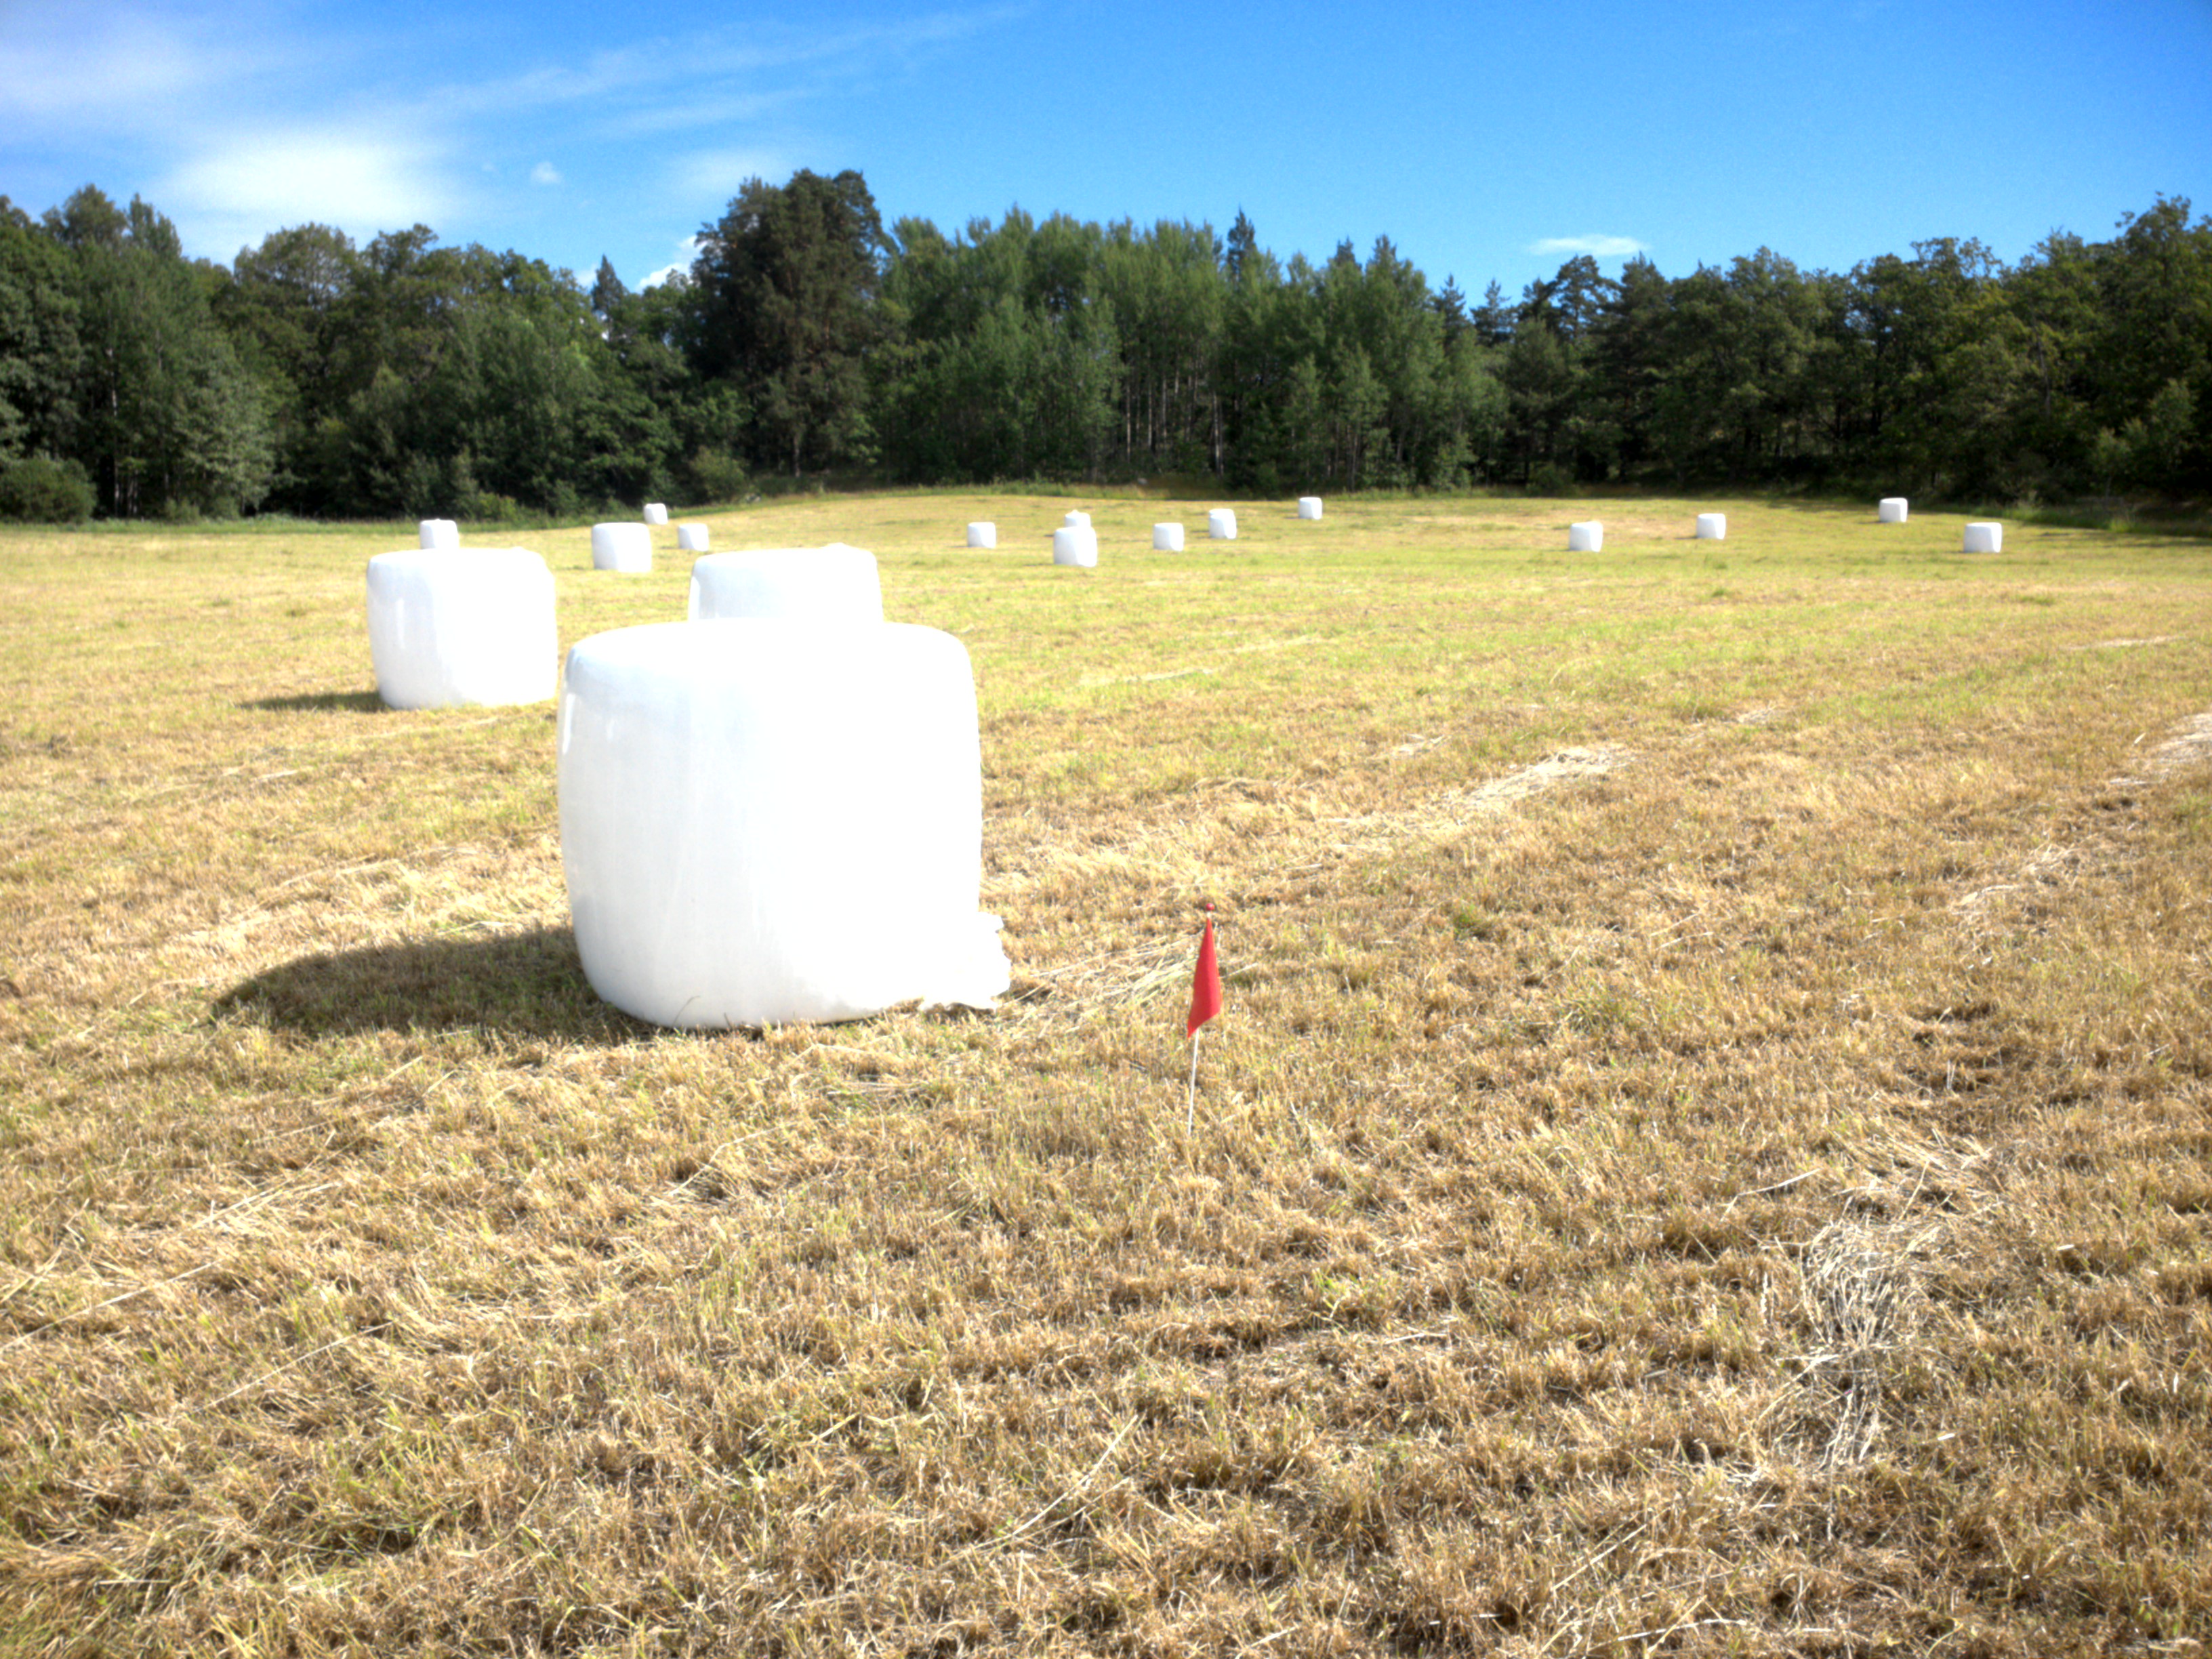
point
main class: Cropland
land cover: Temporary grasslands
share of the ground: > 75 %
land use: Agriculture (excluding fallow land and kitchen gardens)
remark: Harvested field
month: July
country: SE
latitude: 59.3930
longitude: 18.2932
